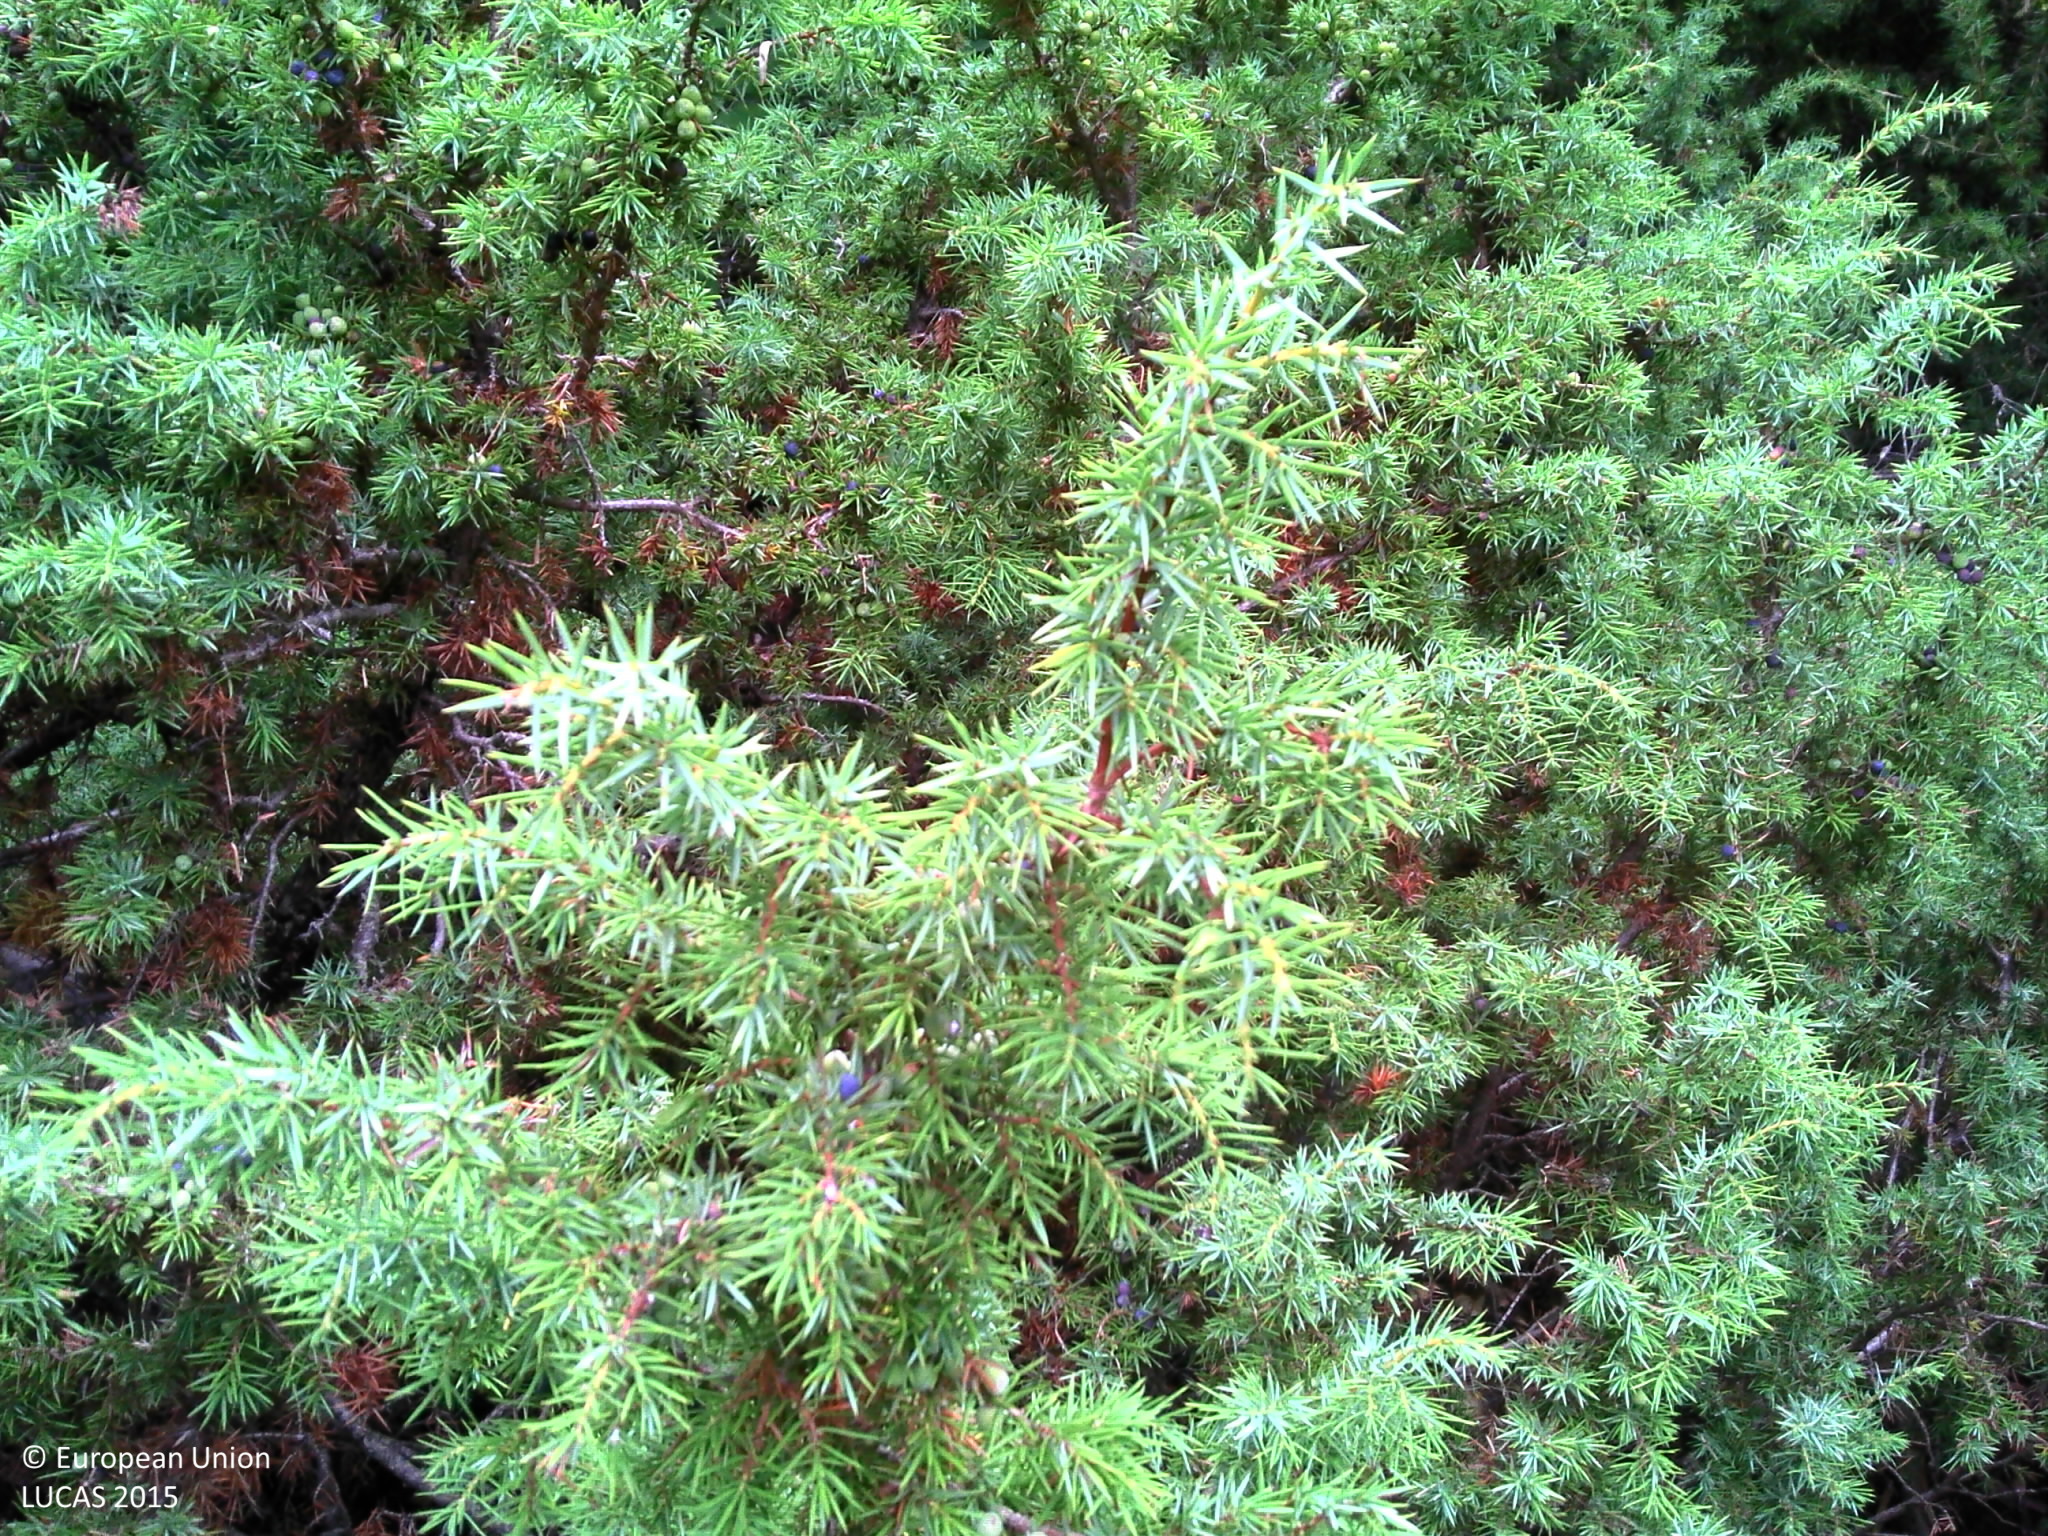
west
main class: Woodland
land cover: Other mixed woodland
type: hemiboreal forest and nemoral coniferous forest and mixed broadleaved-coniferous forest
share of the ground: > 75 %
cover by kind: coniferous forest trees 60 %, broadleaved forest trees 25 %, shrubs 10 %, herbaceous plants 5 %
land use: Forestry
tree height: > 5 m
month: September
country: FR
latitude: 44.6794
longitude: 6.2342
